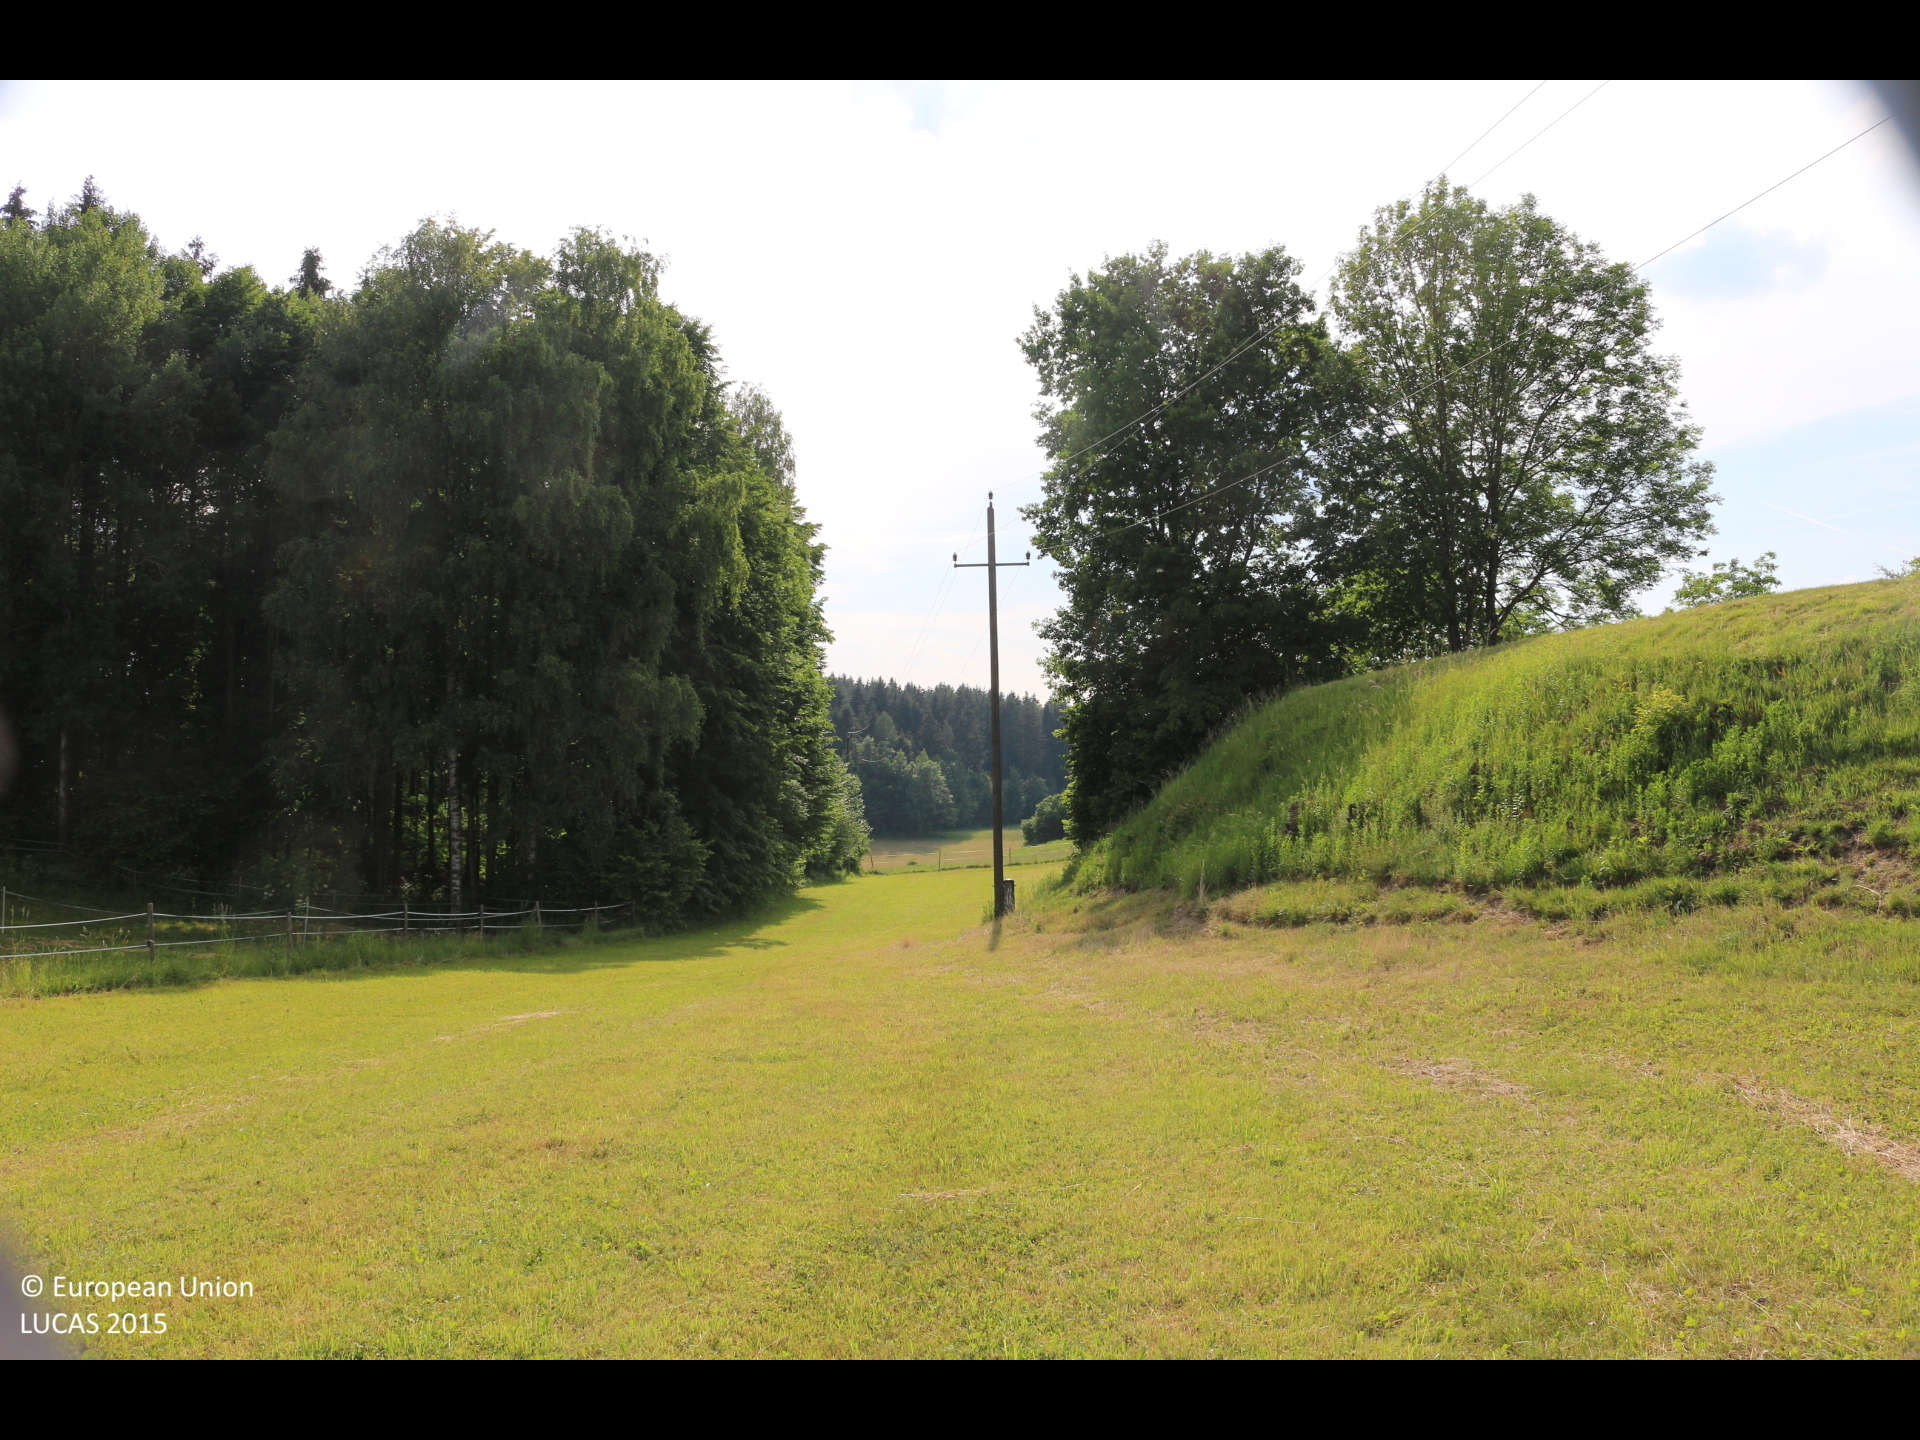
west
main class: Grassland
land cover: Grassland without tree/shrub cover
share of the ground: > 75 %
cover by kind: herbaceous plants 100 %
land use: Agriculture (excluding fallow land and kitchen gardens)
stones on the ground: < 10 %
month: June
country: AT
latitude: 46.5549
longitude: 14.2625
